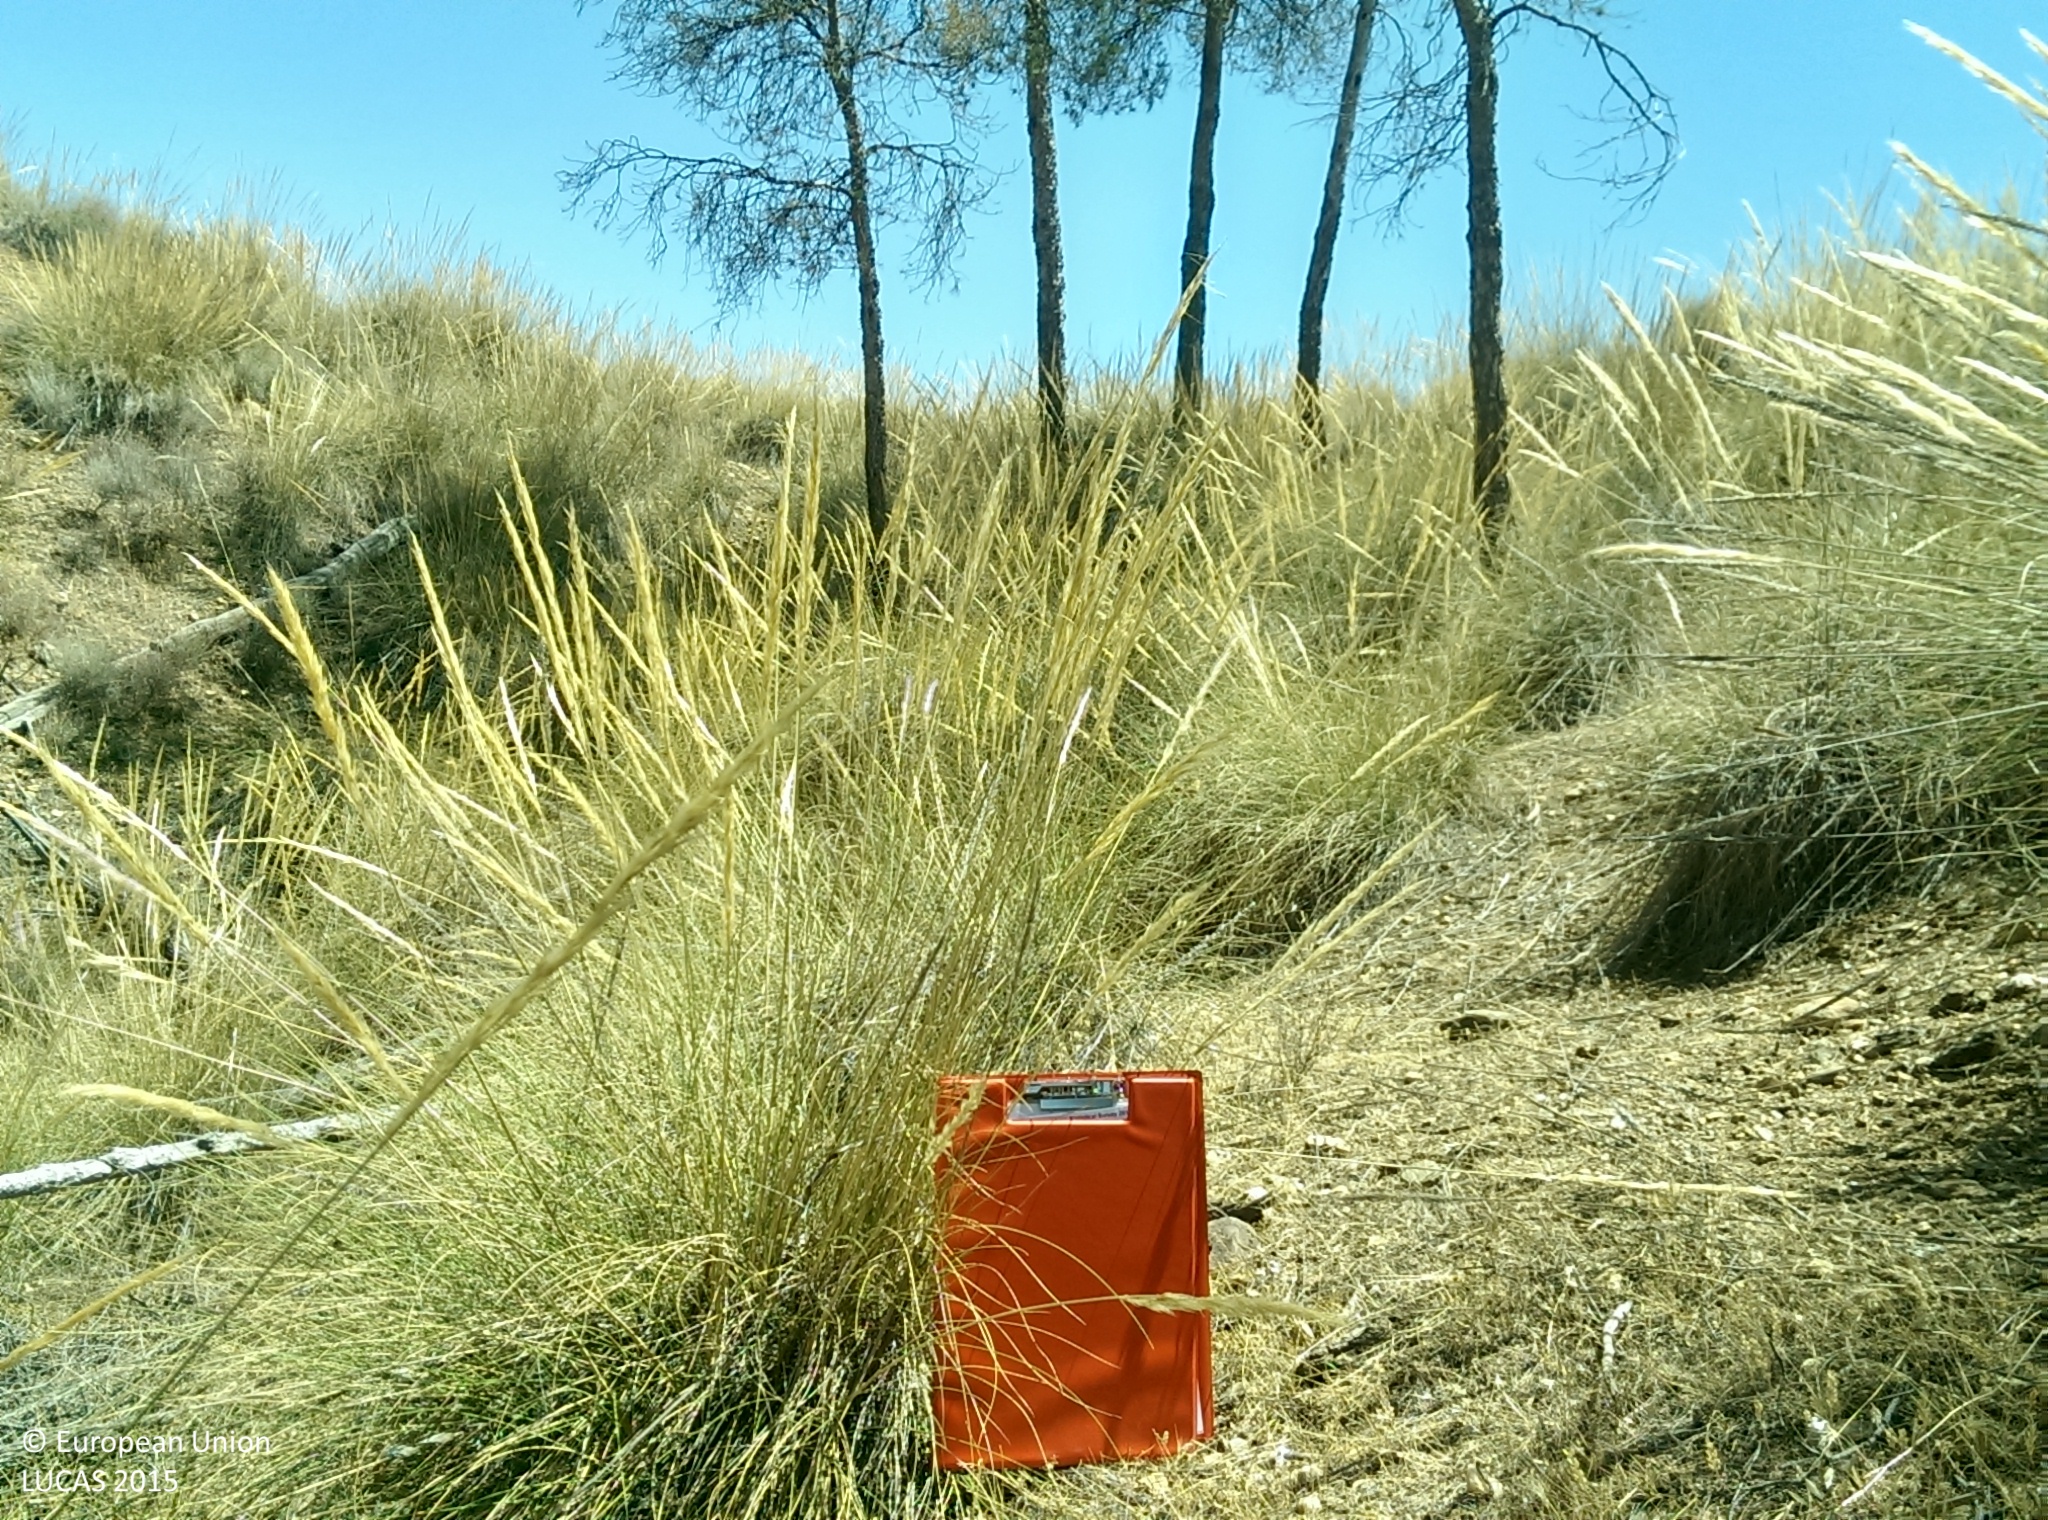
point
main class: Woodland
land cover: Pine dominated coniferous woodland
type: coniferous forest of the mediterranean region
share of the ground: 50 - 75 %
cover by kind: coniferous forest trees 60 %, herbaceous plants 25 %, shrubs 10 %, unconsolidated bare surface 5 %
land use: Forestry
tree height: > 5 m
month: July
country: ES
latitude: 37.3128
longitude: -3.1096
